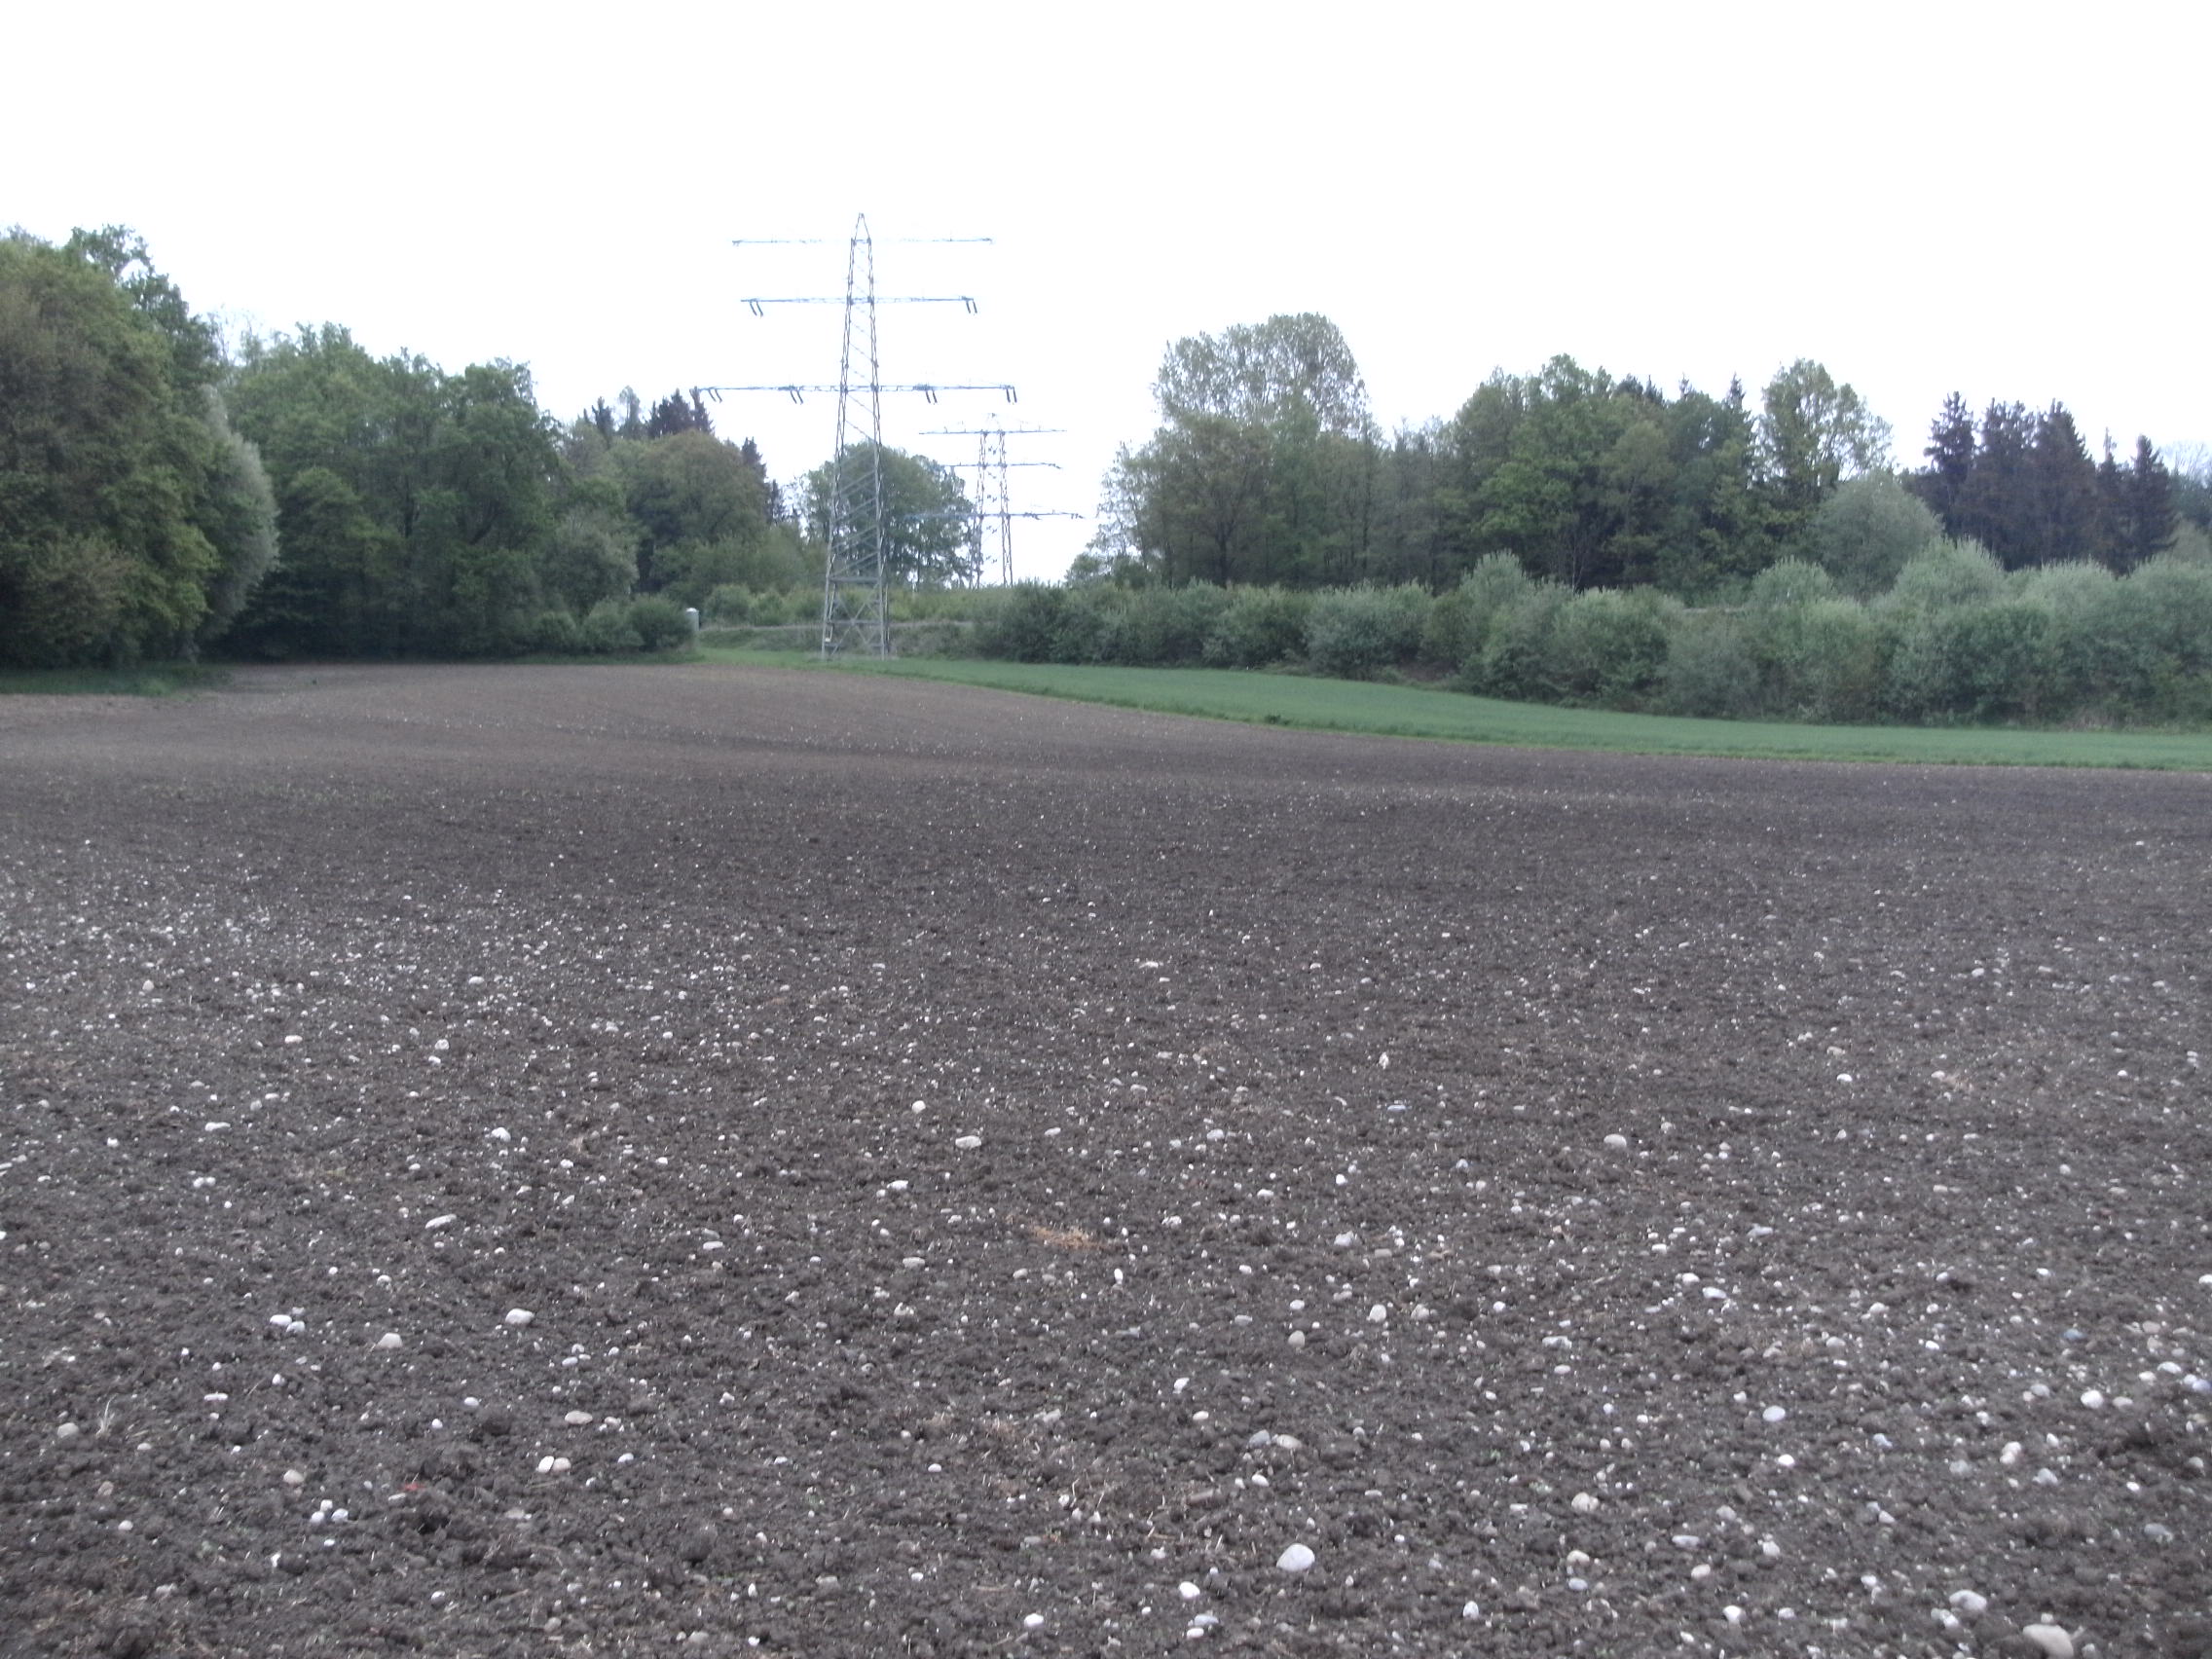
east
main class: Cropland
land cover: Dry pulses
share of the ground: < 10 %
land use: Agriculture (excluding fallow land and kitchen gardens)
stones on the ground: 10 - 25 %
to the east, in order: Dry pulses; Tracks; Barley; Shrubland without tree cover; Grass margins; Railways; Shrubland without tree cover; Ditches and canals; Broadleaved woodland; Grassland without tree/shrub cover
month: May
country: AT
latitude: 48.2216
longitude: 13.5124
